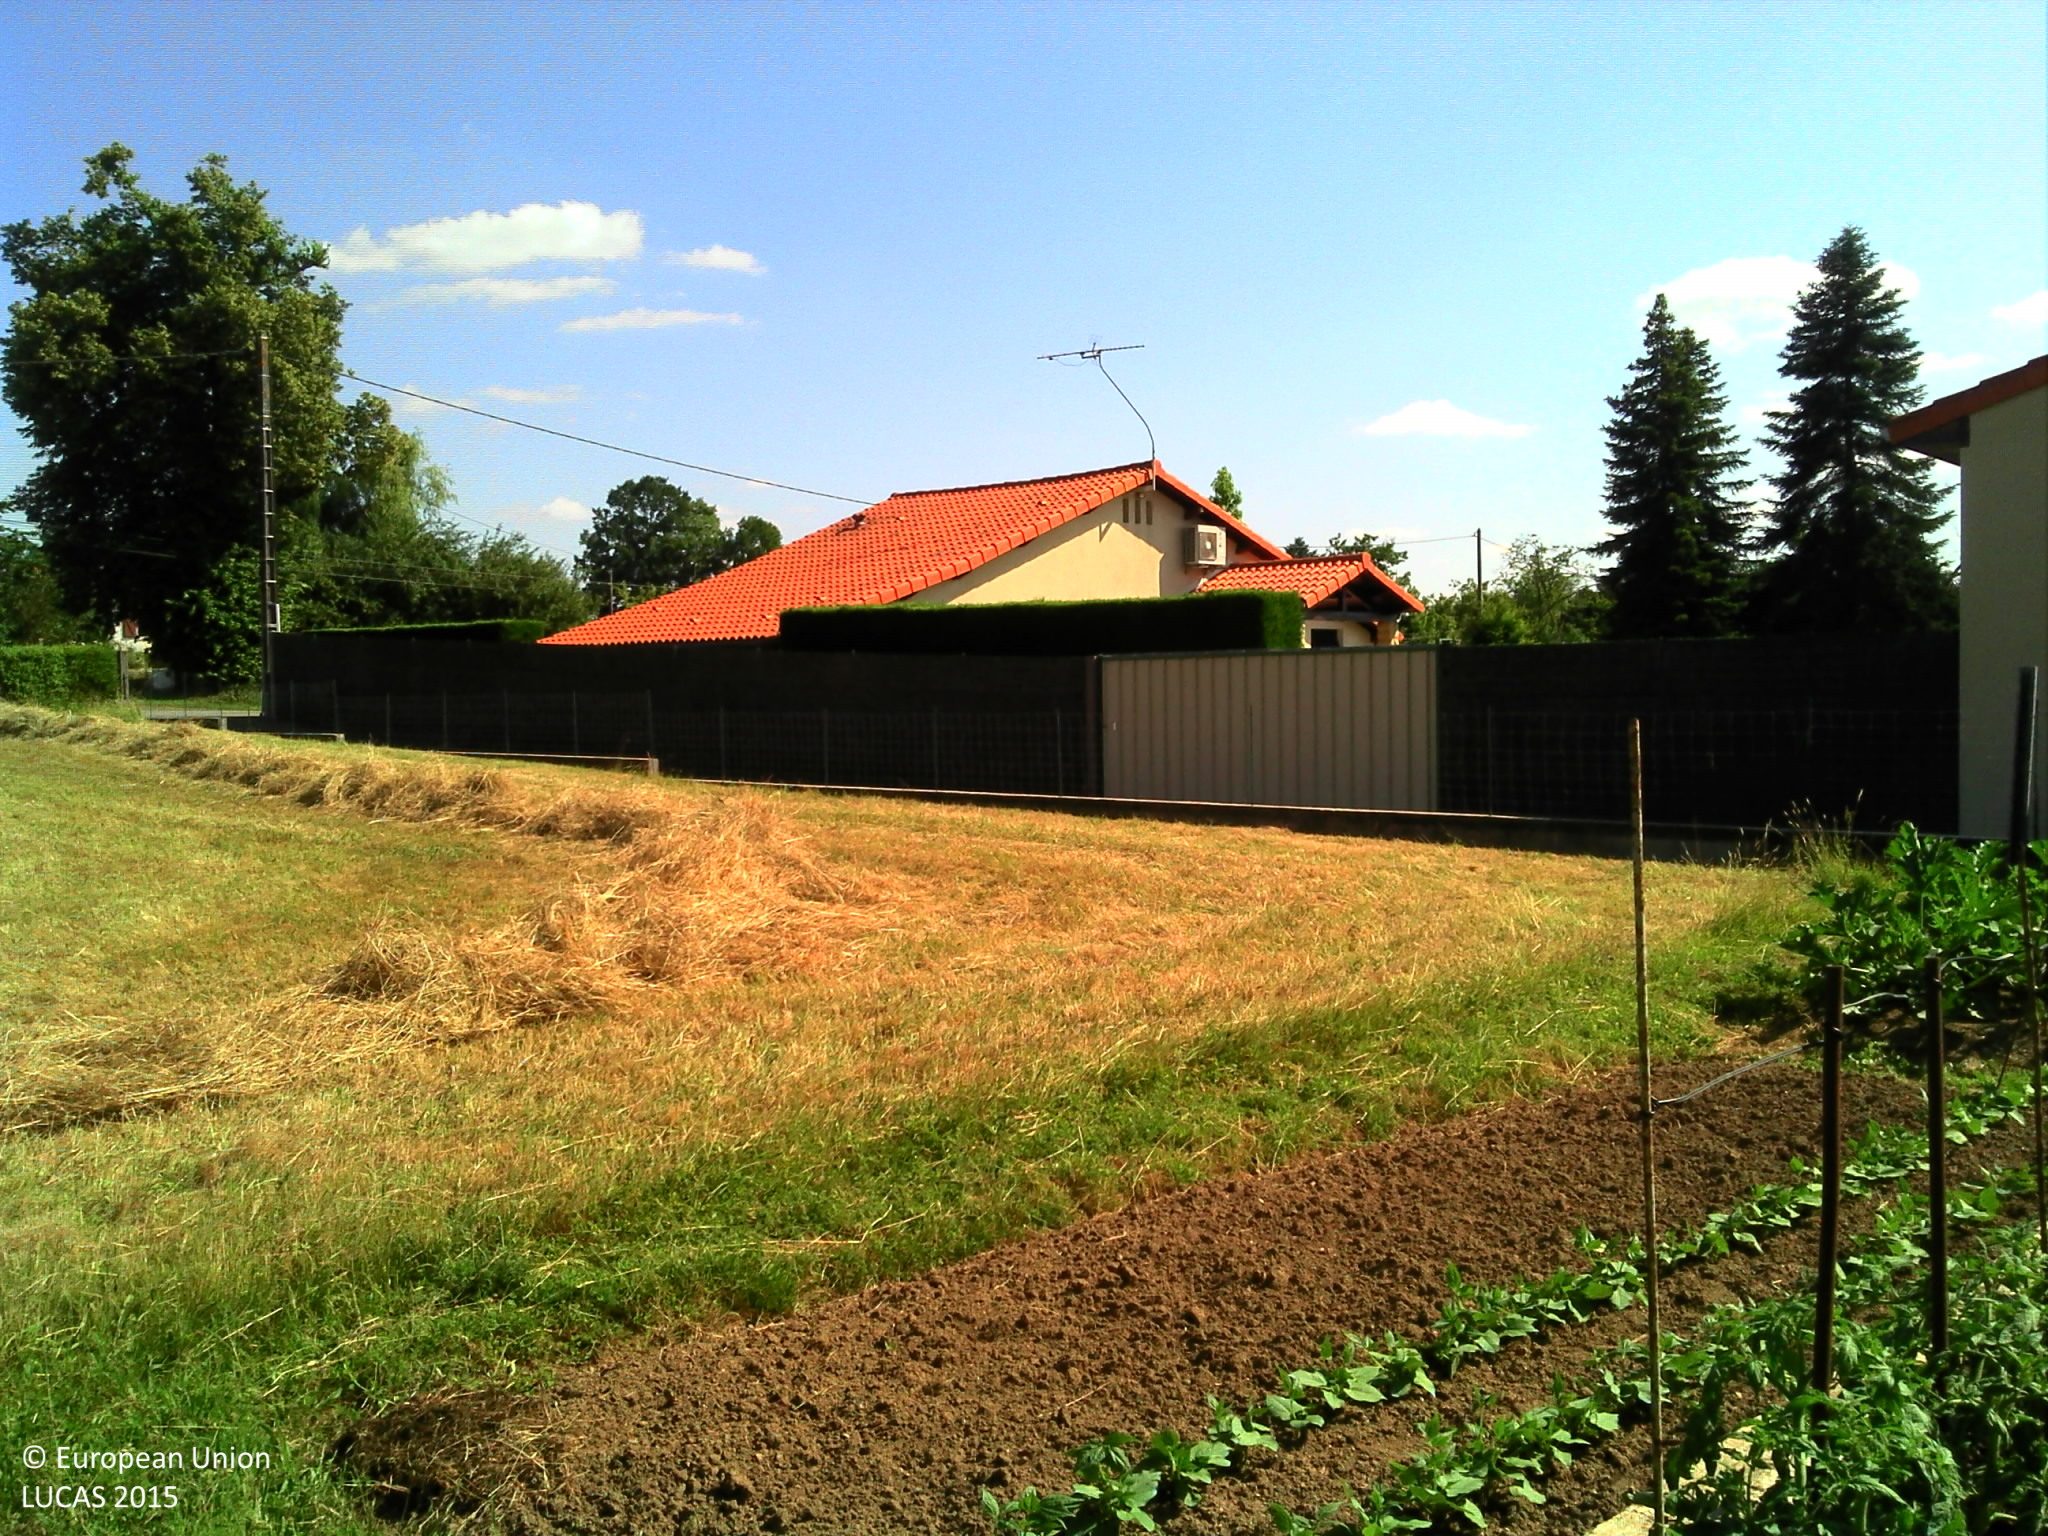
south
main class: Grassland
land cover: Grassland with sparse tree/shrub cover
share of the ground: > 75 %
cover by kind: herbaceous plants 95 %, broadleaved forest trees 5 %
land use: Agriculture (excluding fallow land and kitchen gardens)
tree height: > 5 m
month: June
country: FR
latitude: 45.8860
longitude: 0.6440
